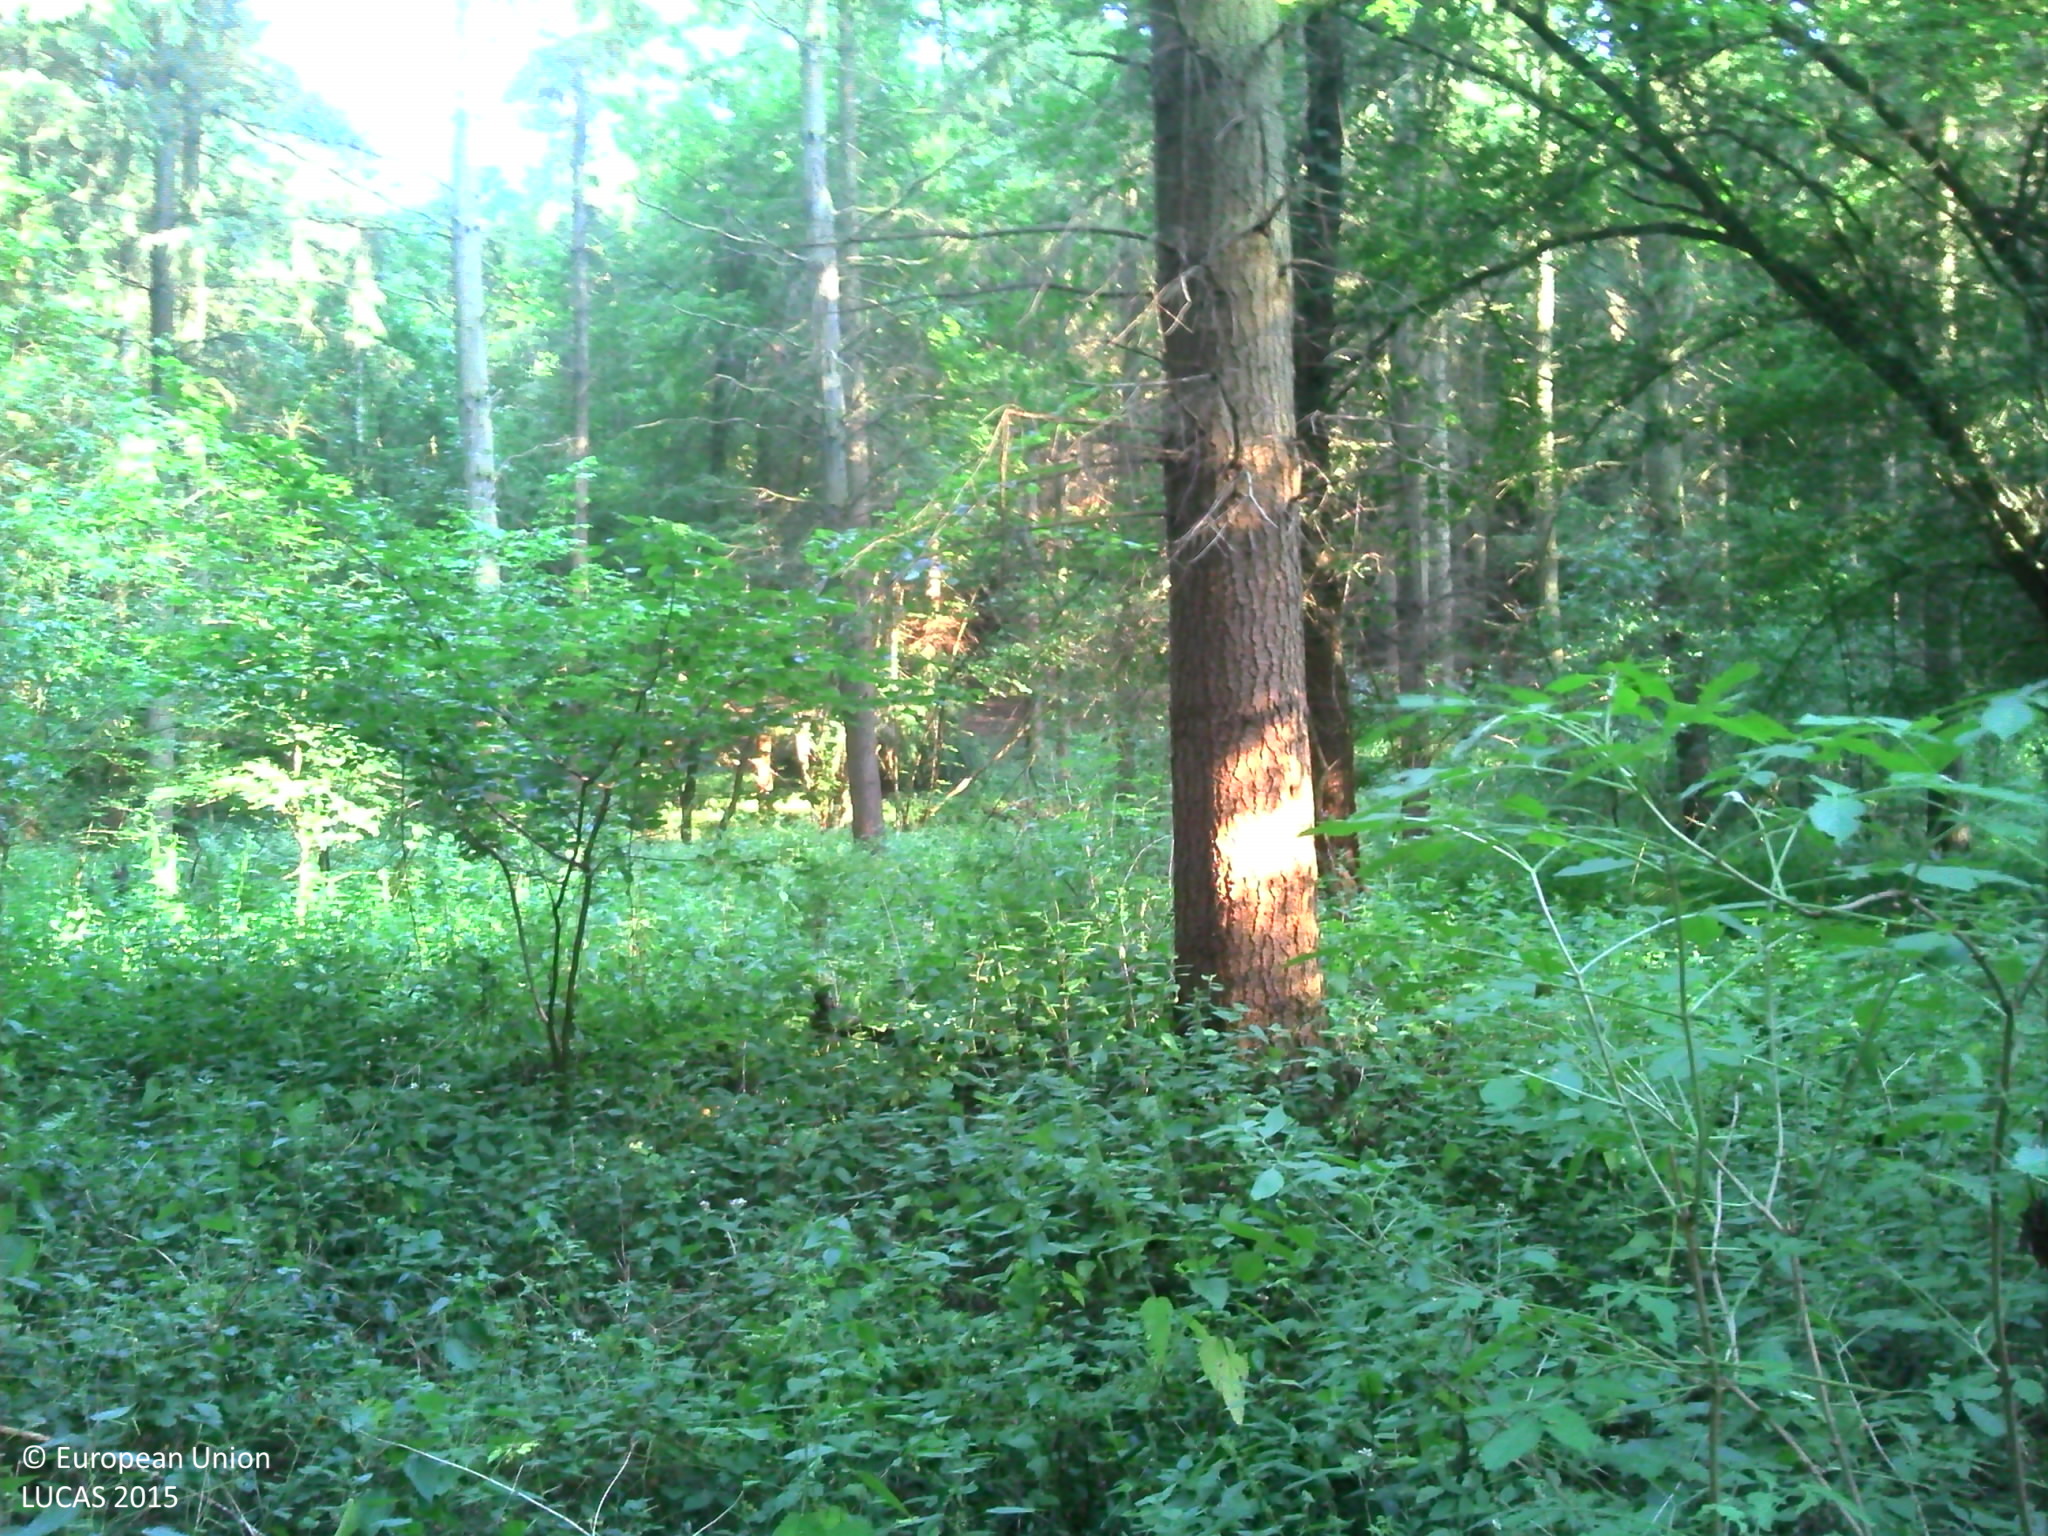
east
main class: Woodland
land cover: Spruce dominated mixed woodland
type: mesophytic deciduous forest
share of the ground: > 75 %
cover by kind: coniferous forest trees 45 %, broadleaved forest trees 20 %, consolidated bare surface 20 %, herbaceous plants 15 %
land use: Forestry
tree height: > 5 m
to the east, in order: Spruce dominated mixed woodland; Broadleaved woodland; Tracks; Spruce dominated coniferous woodland
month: July
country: FR
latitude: 48.8761
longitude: 1.3229
